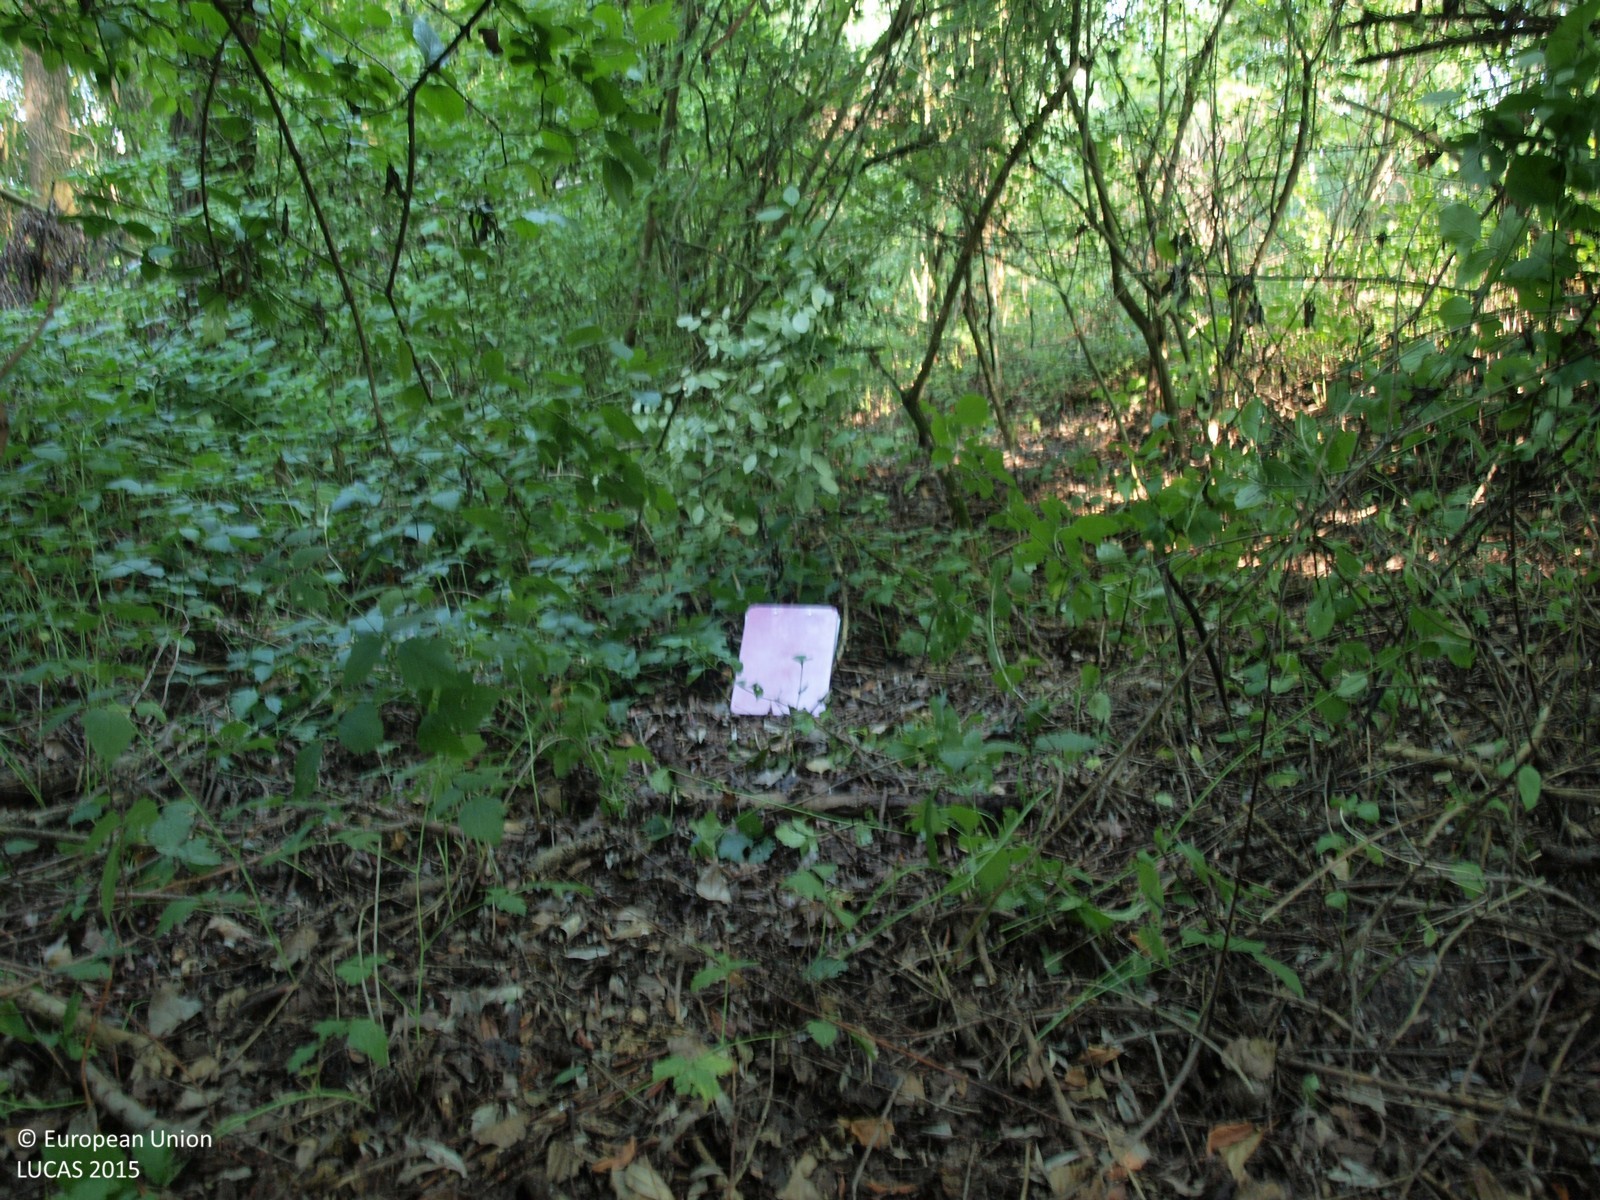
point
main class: Woodland
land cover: Broadleaved woodland
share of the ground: > 75 %
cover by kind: broadleaved forest trees 100 %
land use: Forestry
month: August
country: HR
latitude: 45.7569
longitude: 16.1820
